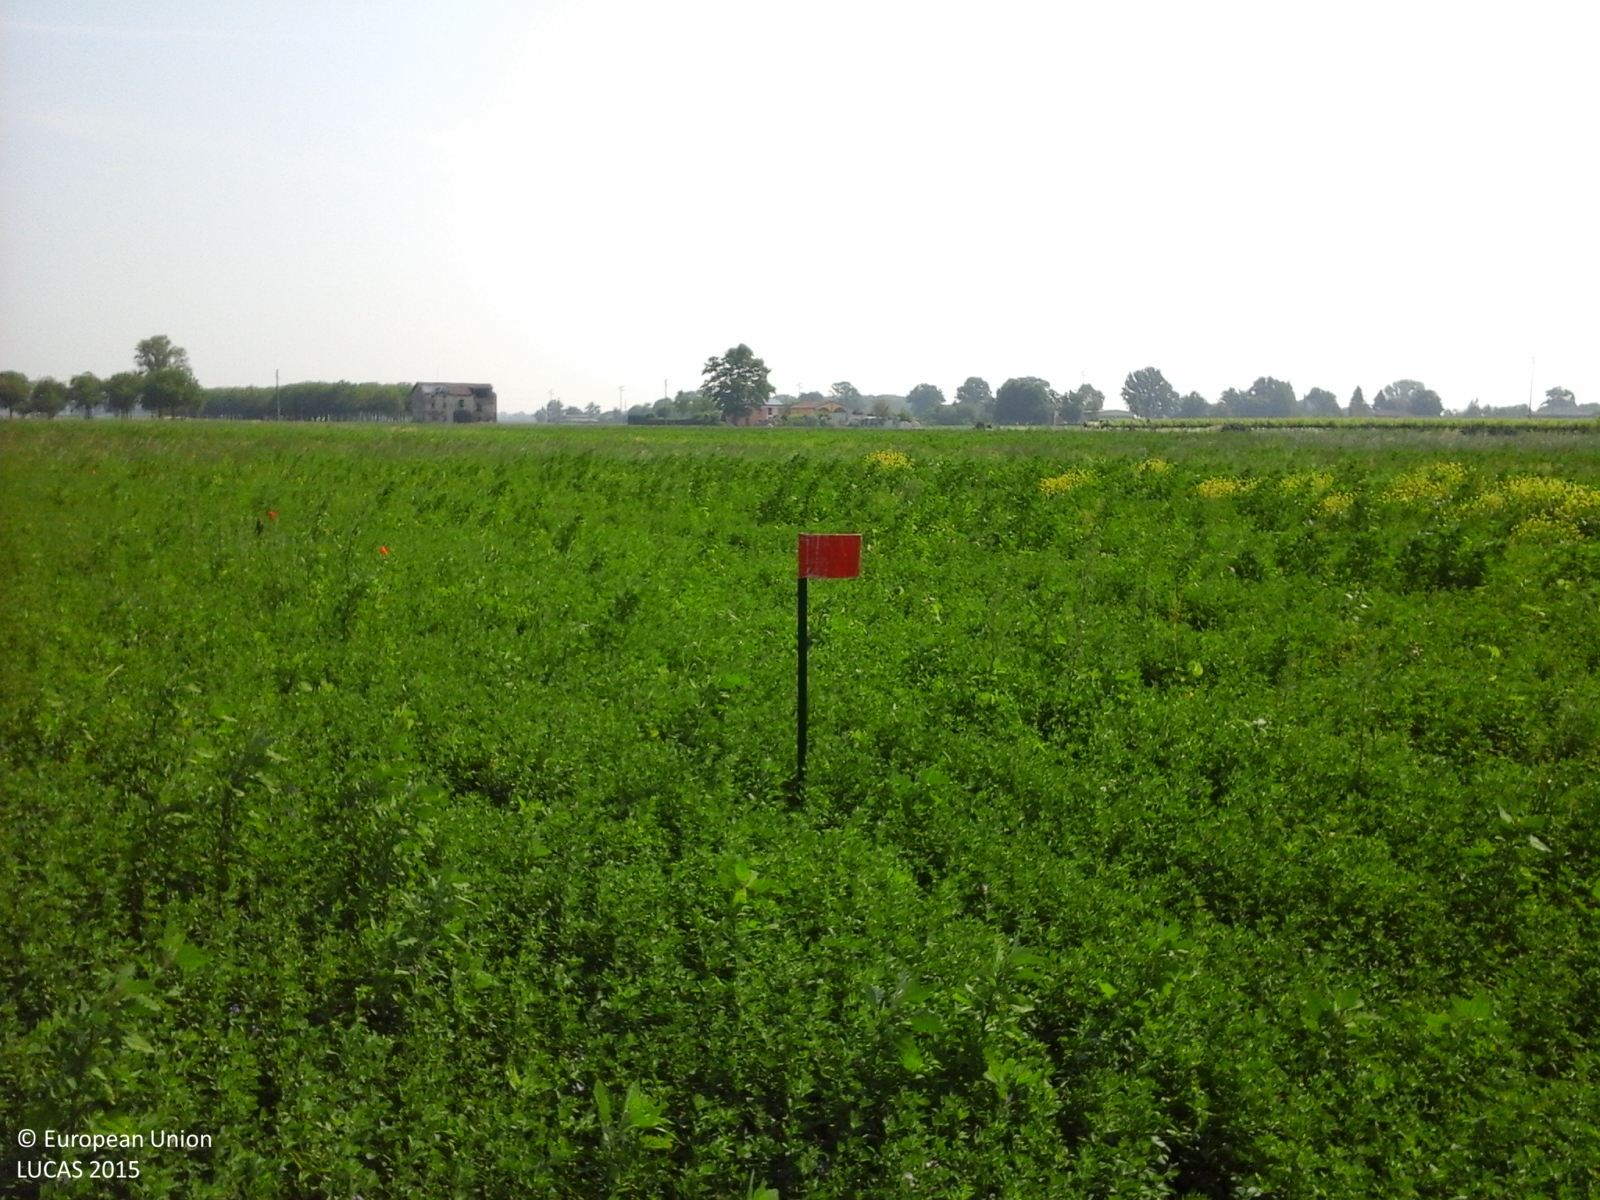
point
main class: Cropland
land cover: Lucerne
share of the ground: > 75 %
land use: Agriculture (excluding fallow land and kitchen gardens)
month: May
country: IT
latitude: 44.7082
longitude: 10.7935
